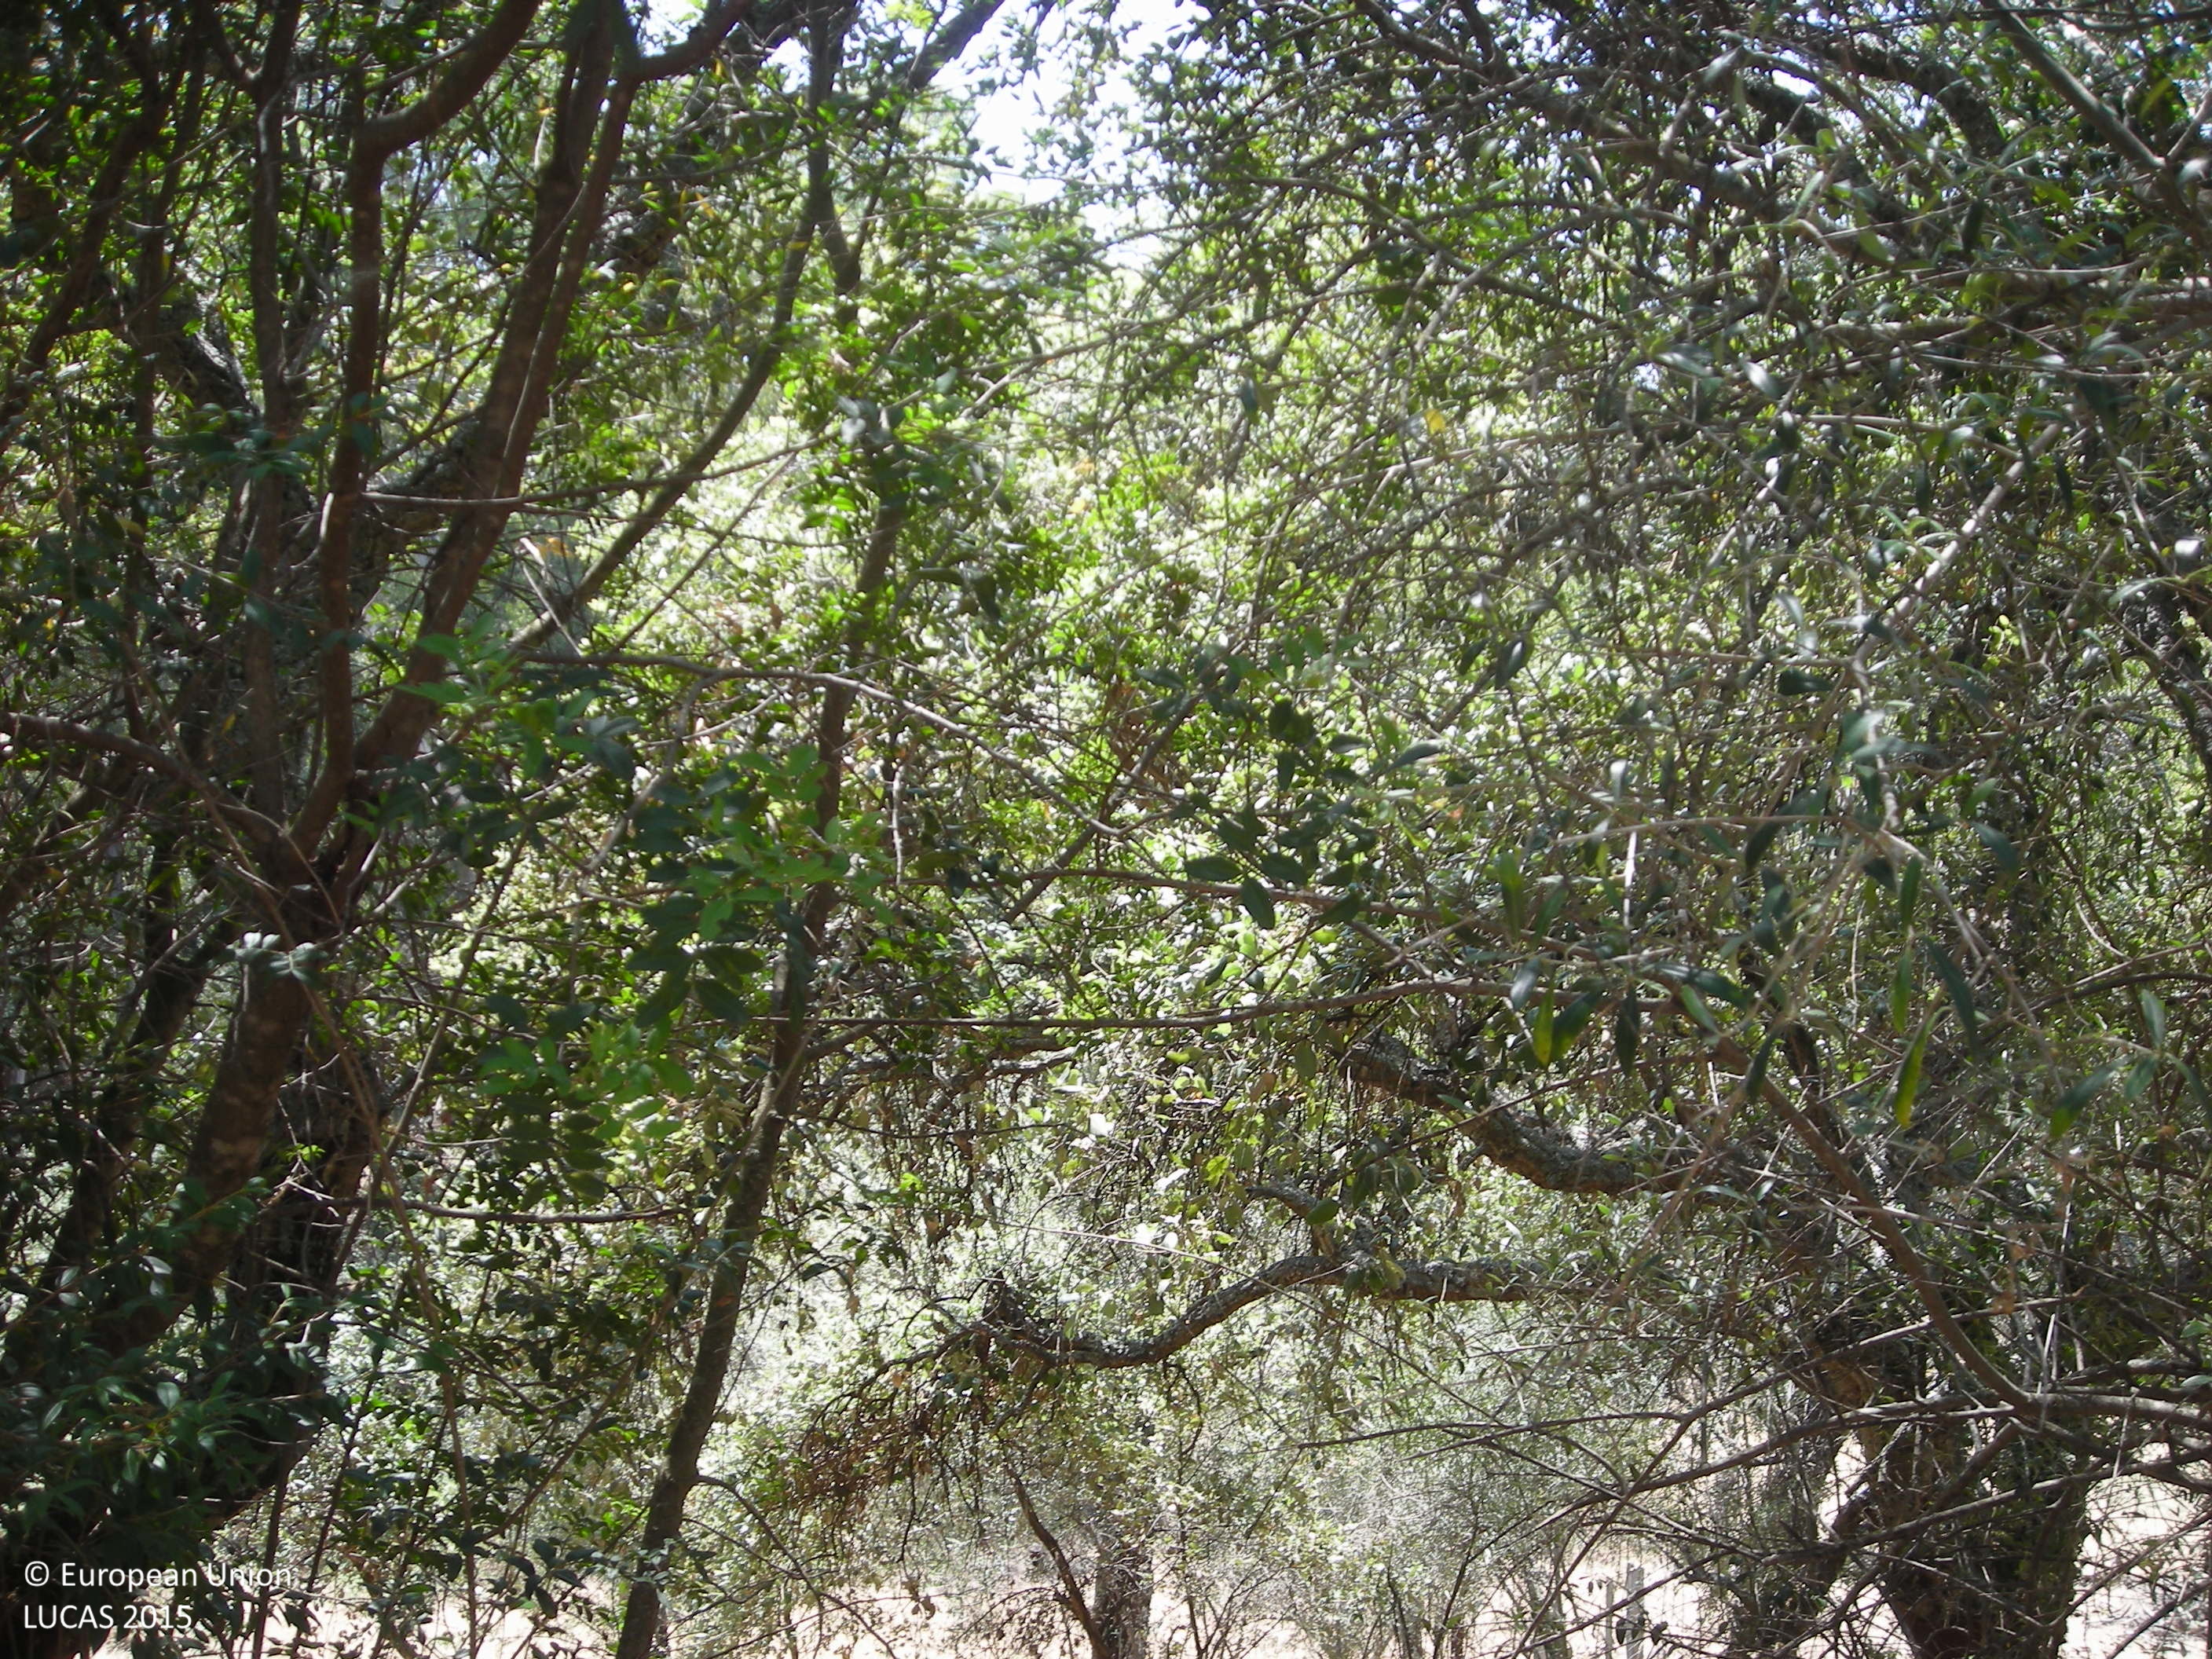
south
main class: Shrubland
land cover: Shrubland without tree cover
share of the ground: > 75 %
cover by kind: shrubs 100 %
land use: Semi-natural and natural areas not in use
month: June
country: ES
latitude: 39.0858
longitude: -5.4783
